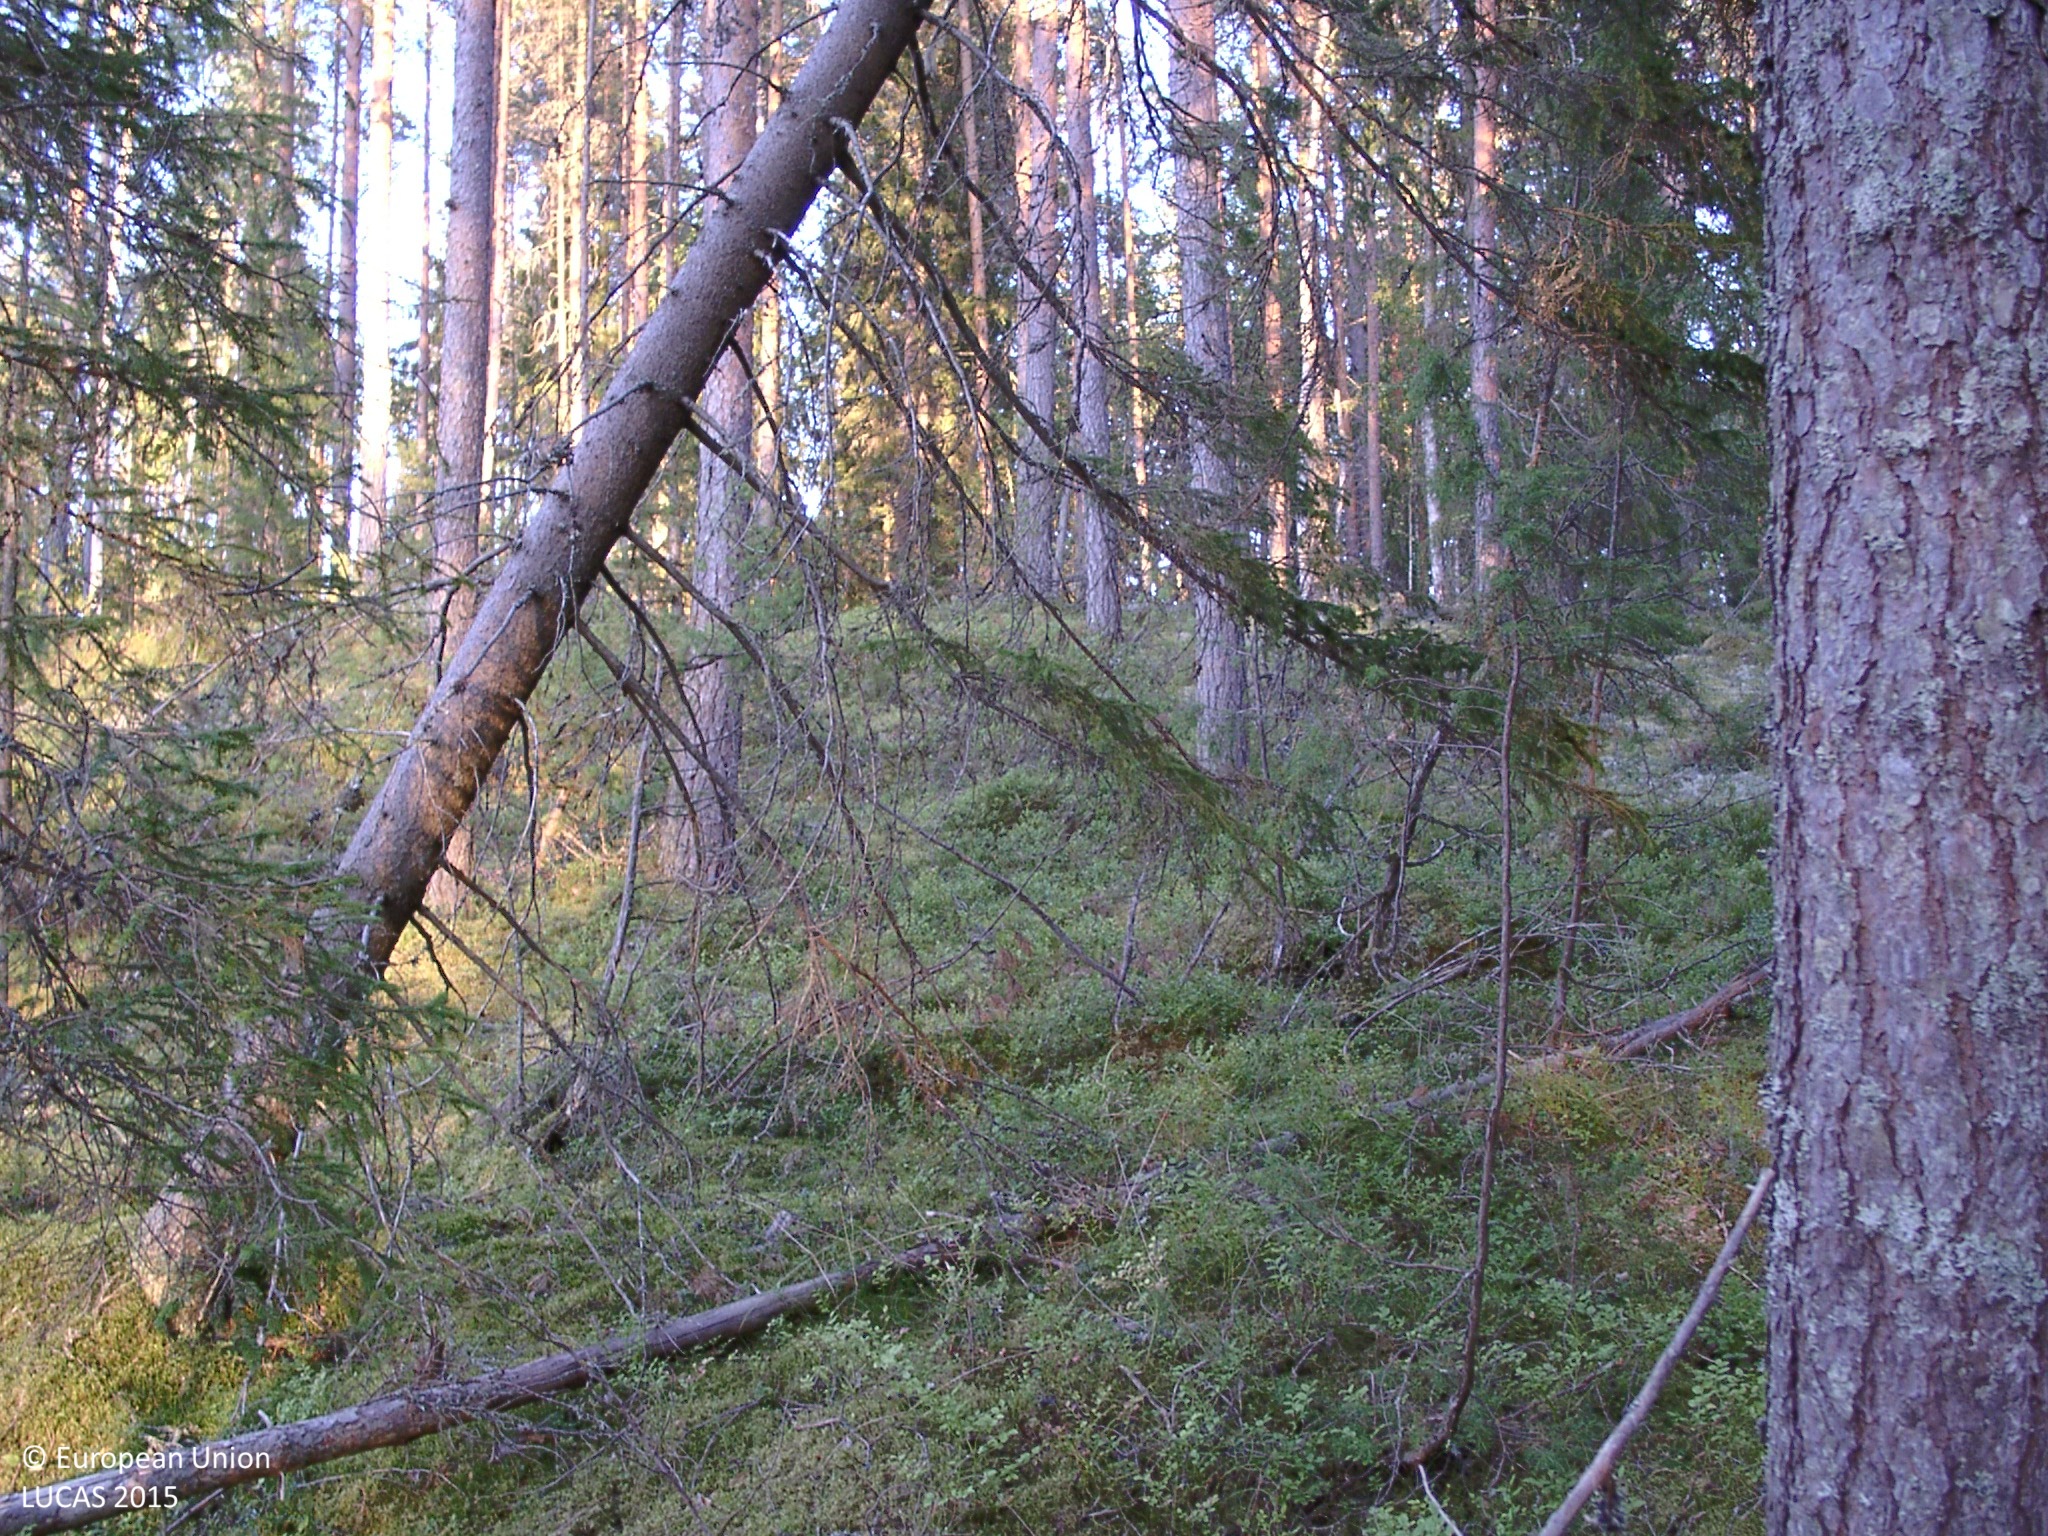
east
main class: Woodland
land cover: Other coniferous woodland
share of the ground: > 75 %
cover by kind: coniferous forest trees 90 %, shrubs 5 %, lichens and mosses 5 %
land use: Forestry
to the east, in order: Other coniferous woodland; Pine dominated coniferous woodland; Other coniferous woodland; Tracks; Pine dominated coniferous woodland; Tracks; Pine dominated coniferous woodland; Other mixed woodland; Spruce dominated mixed woodland
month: August
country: FI
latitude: 61.9711
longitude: 25.1206
